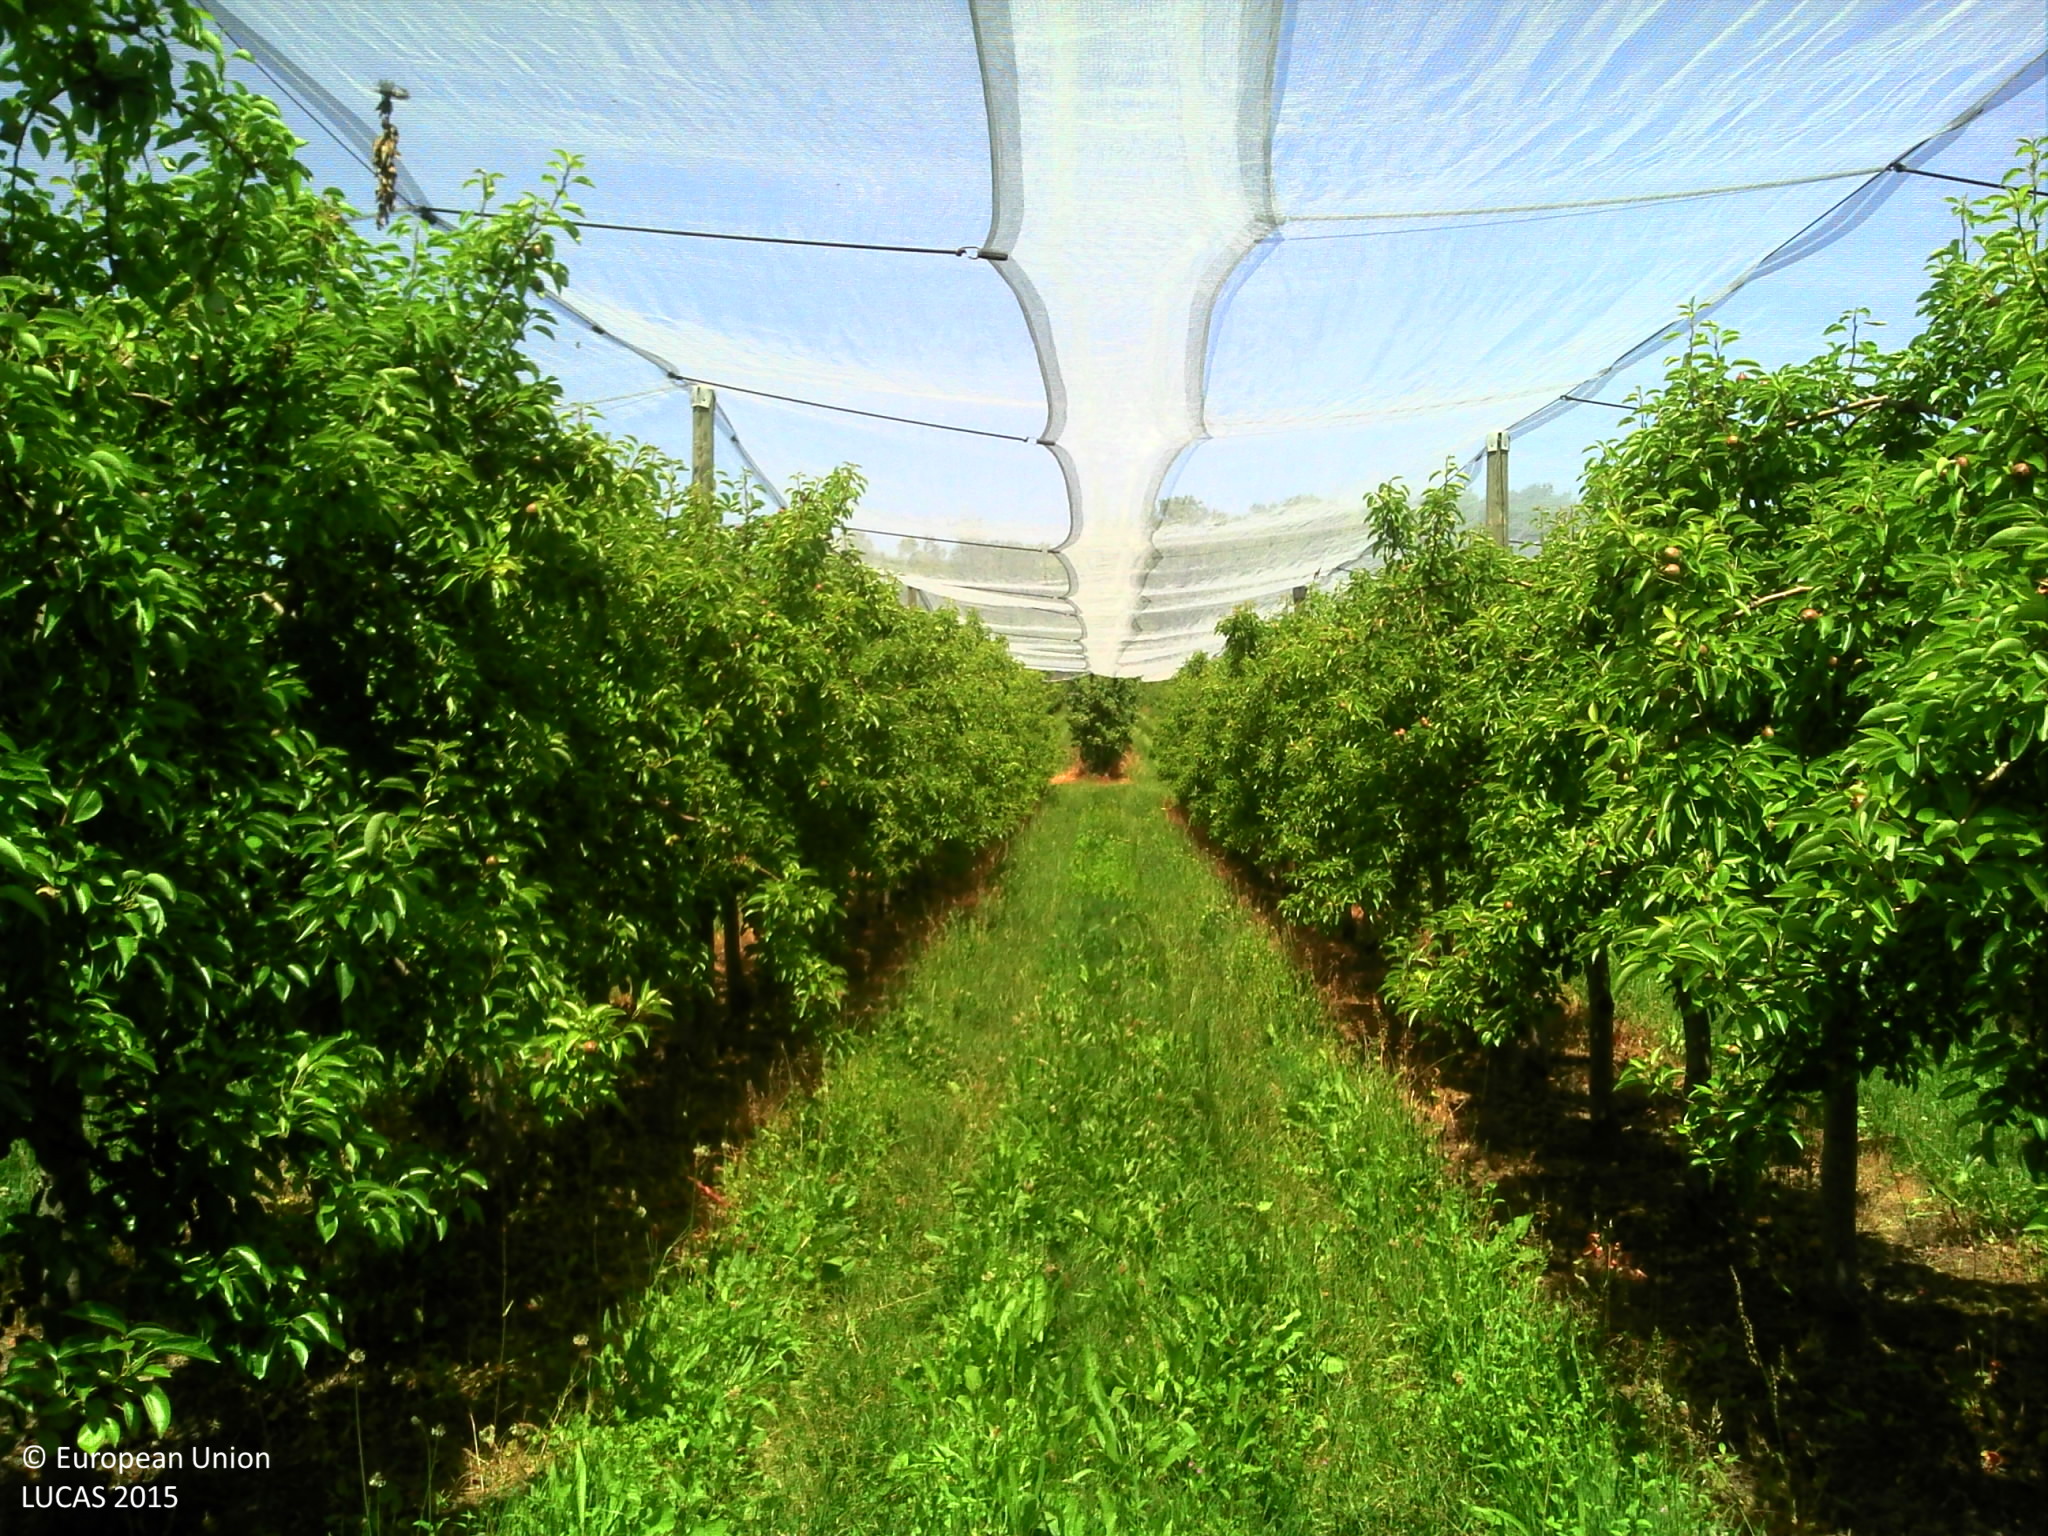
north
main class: Cropland
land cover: Pear fruit
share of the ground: 50 - 75 %
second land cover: Grassland without tree/shrub cover
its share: 50 - 75 %
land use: Agriculture (excluding fallow land and kitchen gardens)
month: June
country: FR
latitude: 46.4802
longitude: 4.8569
